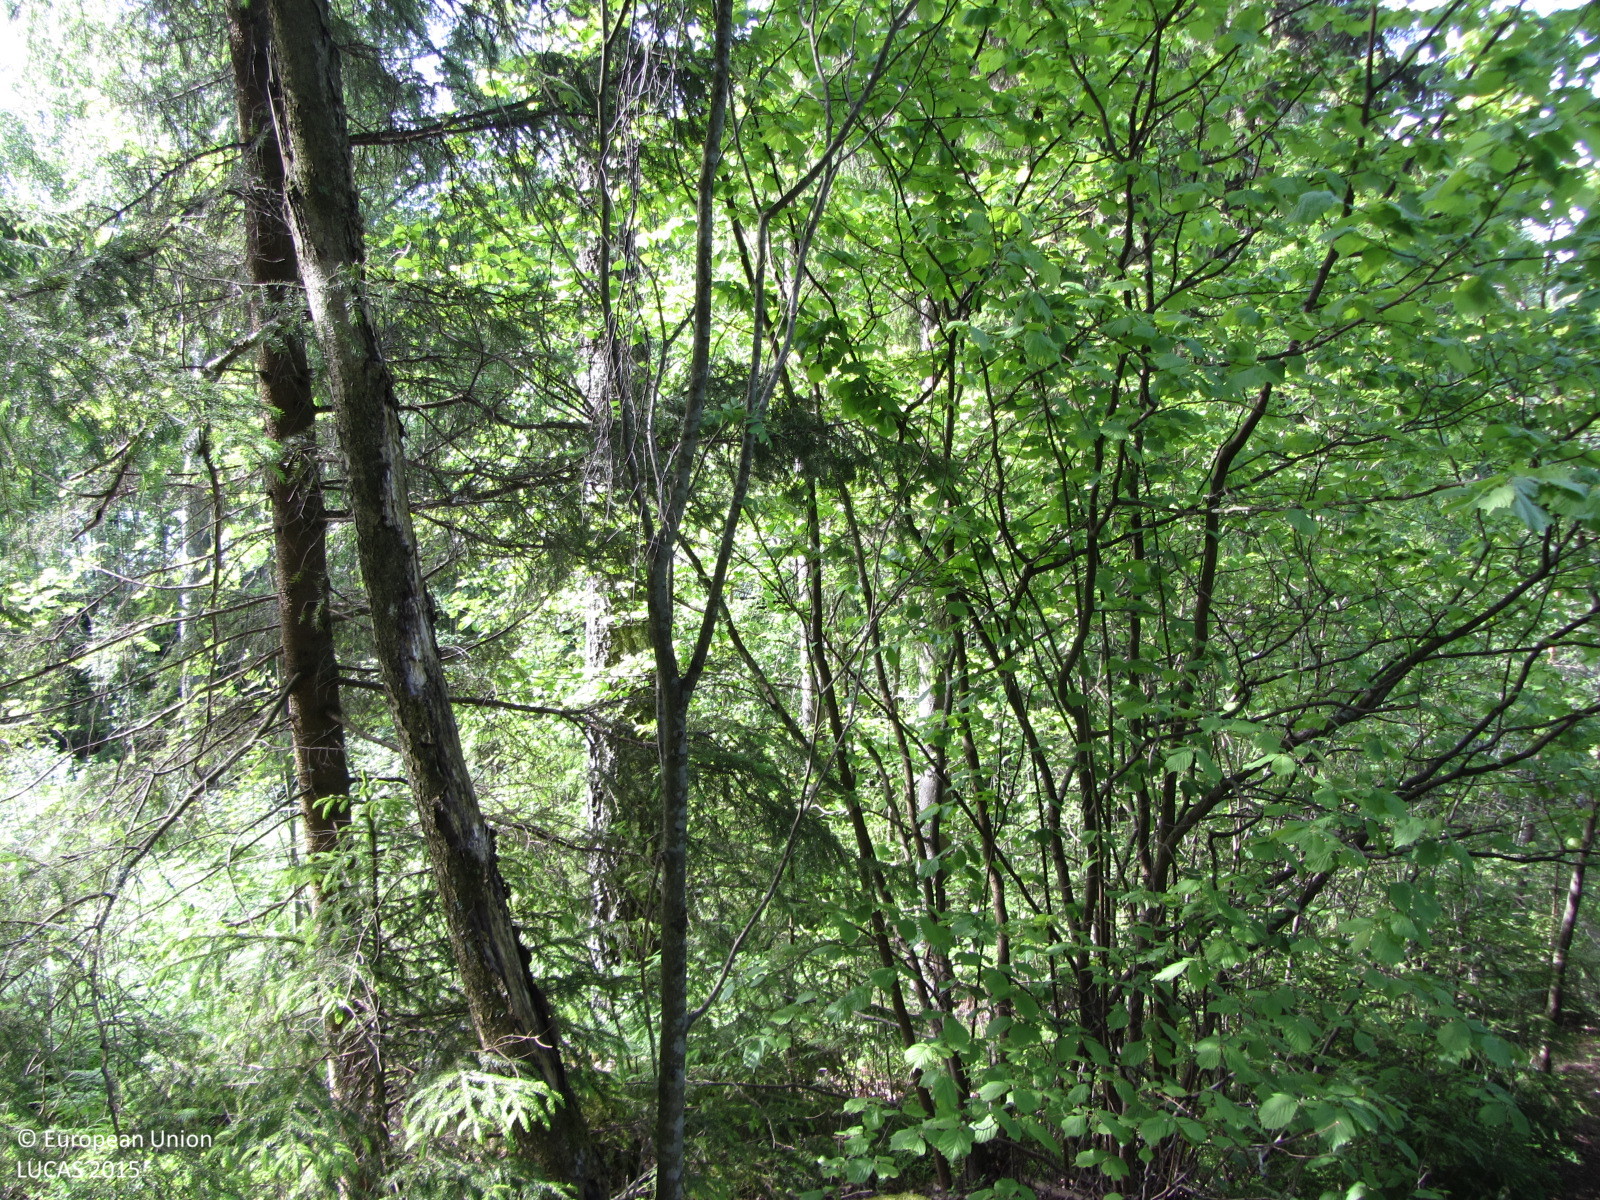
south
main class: Woodland
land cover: Spruce dominated mixed woodland
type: boreal forest
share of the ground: > 75 %
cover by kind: broadleaved forest trees 45 %, coniferous forest trees 40 %, shrubs 10 %, herbaceous plants 5 %
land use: Forestry
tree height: > 5 m
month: June
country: FI
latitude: 60.1707
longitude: 24.2148
